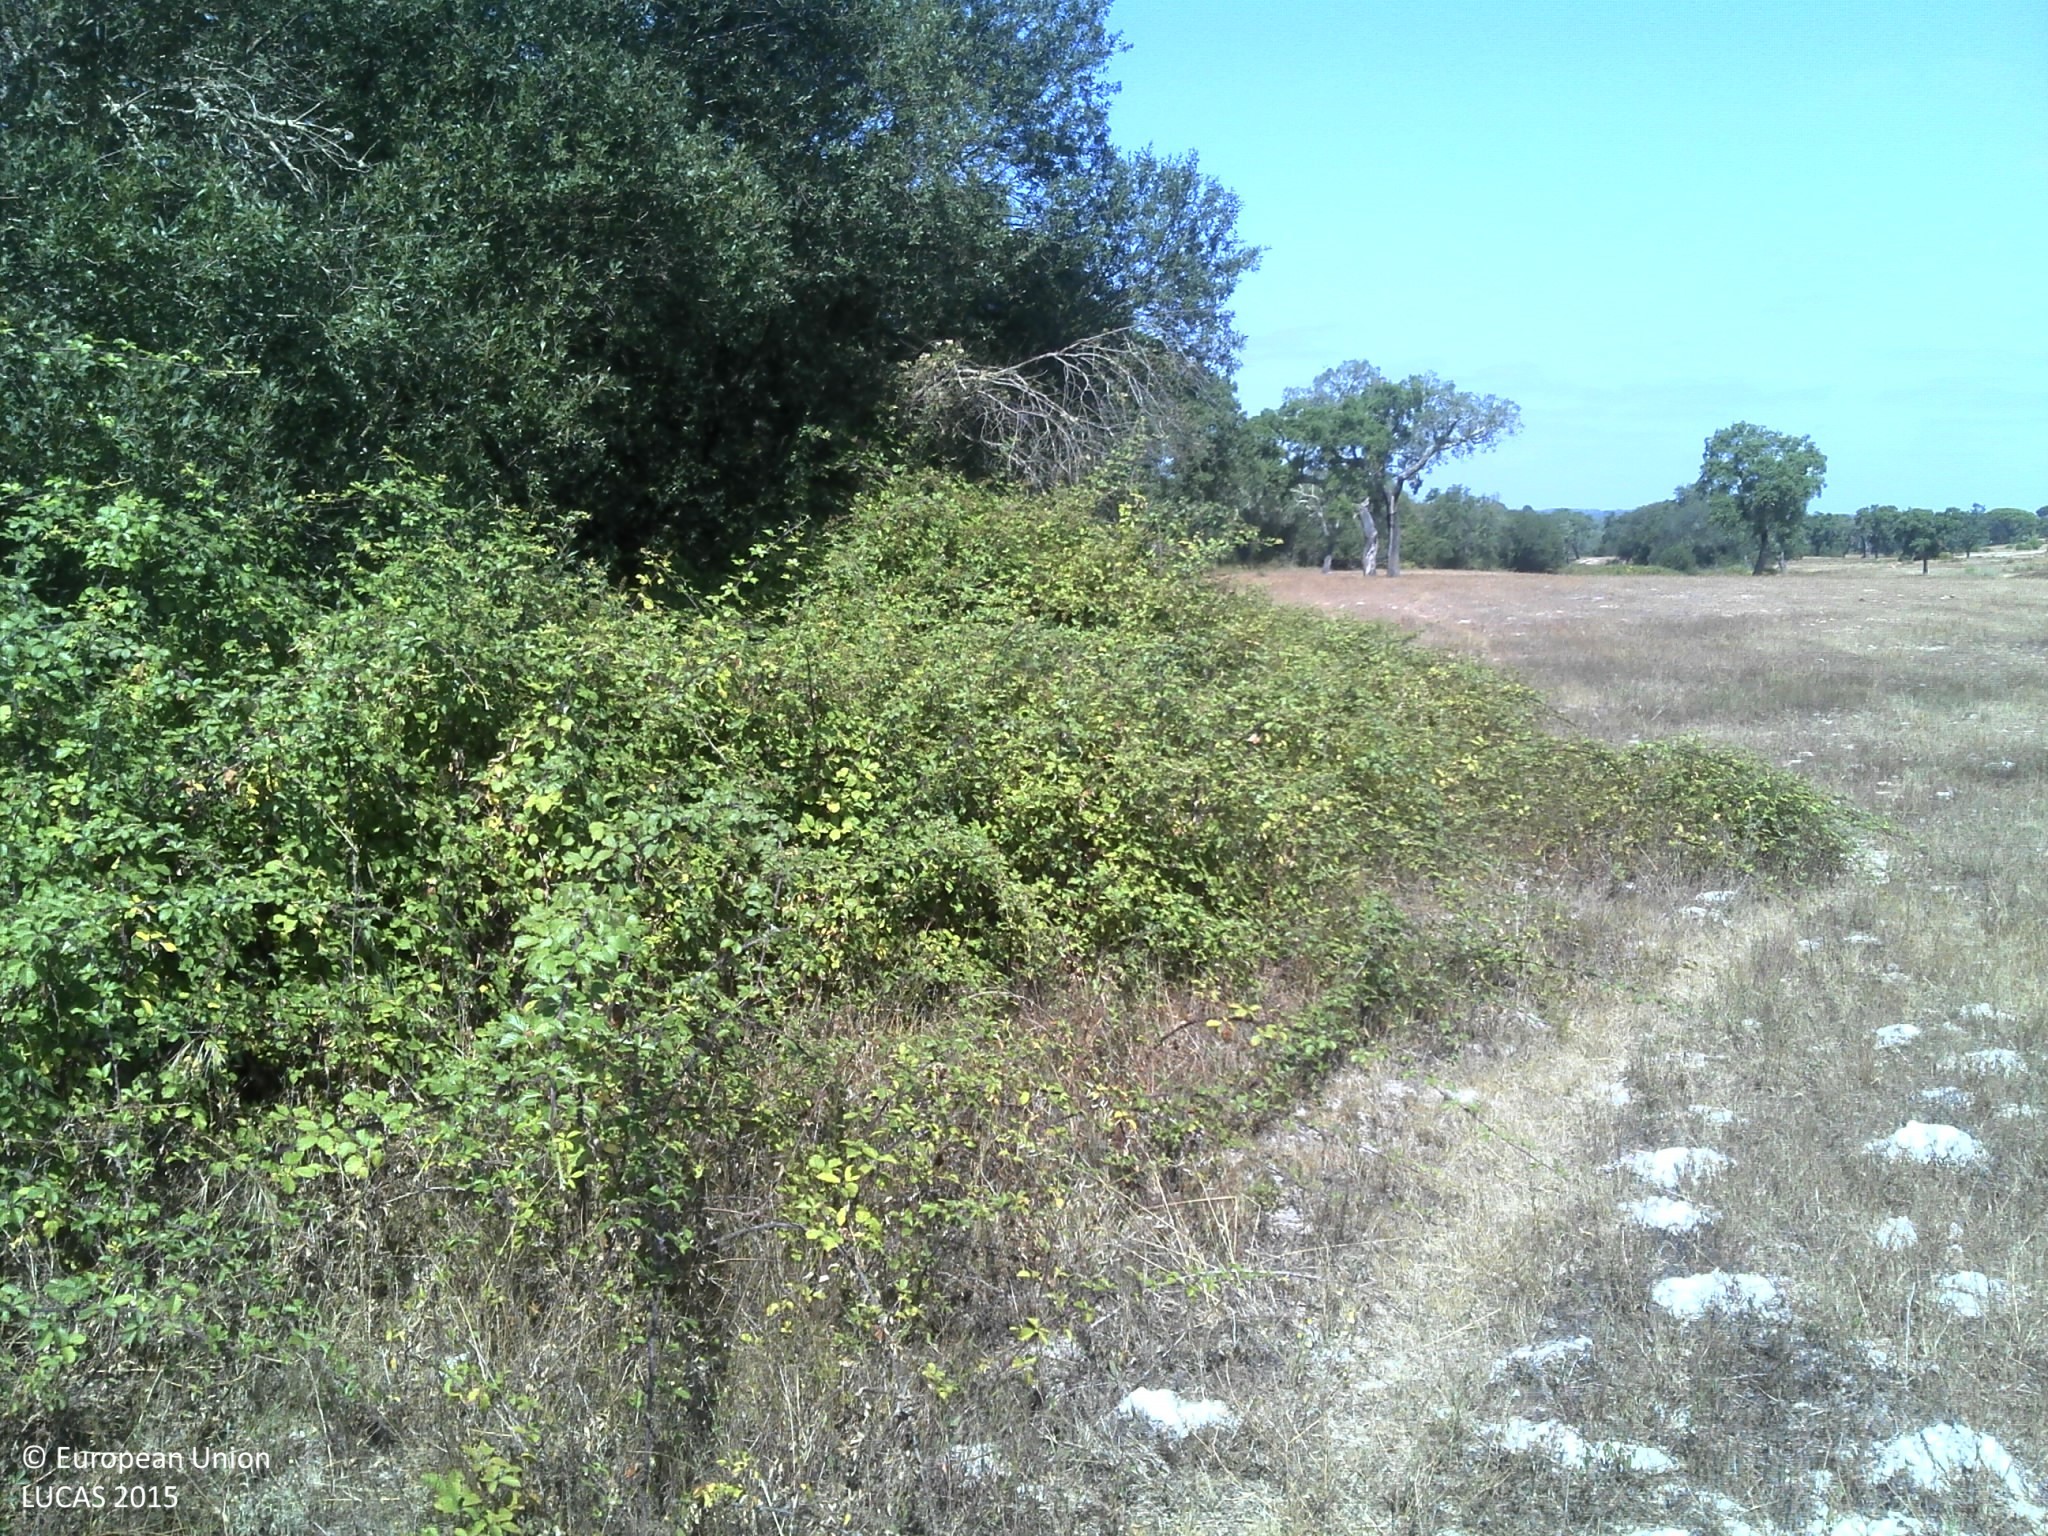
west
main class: Grassland
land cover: Grassland without tree/shrub cover
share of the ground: 25 - 50 %
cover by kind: unconsolidated bare surface 60 %, herbaceous plants 40 %
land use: Agriculture (excluding fallow land and kitchen gardens)
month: July
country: PT
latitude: 39.0643
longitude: -8.3078
